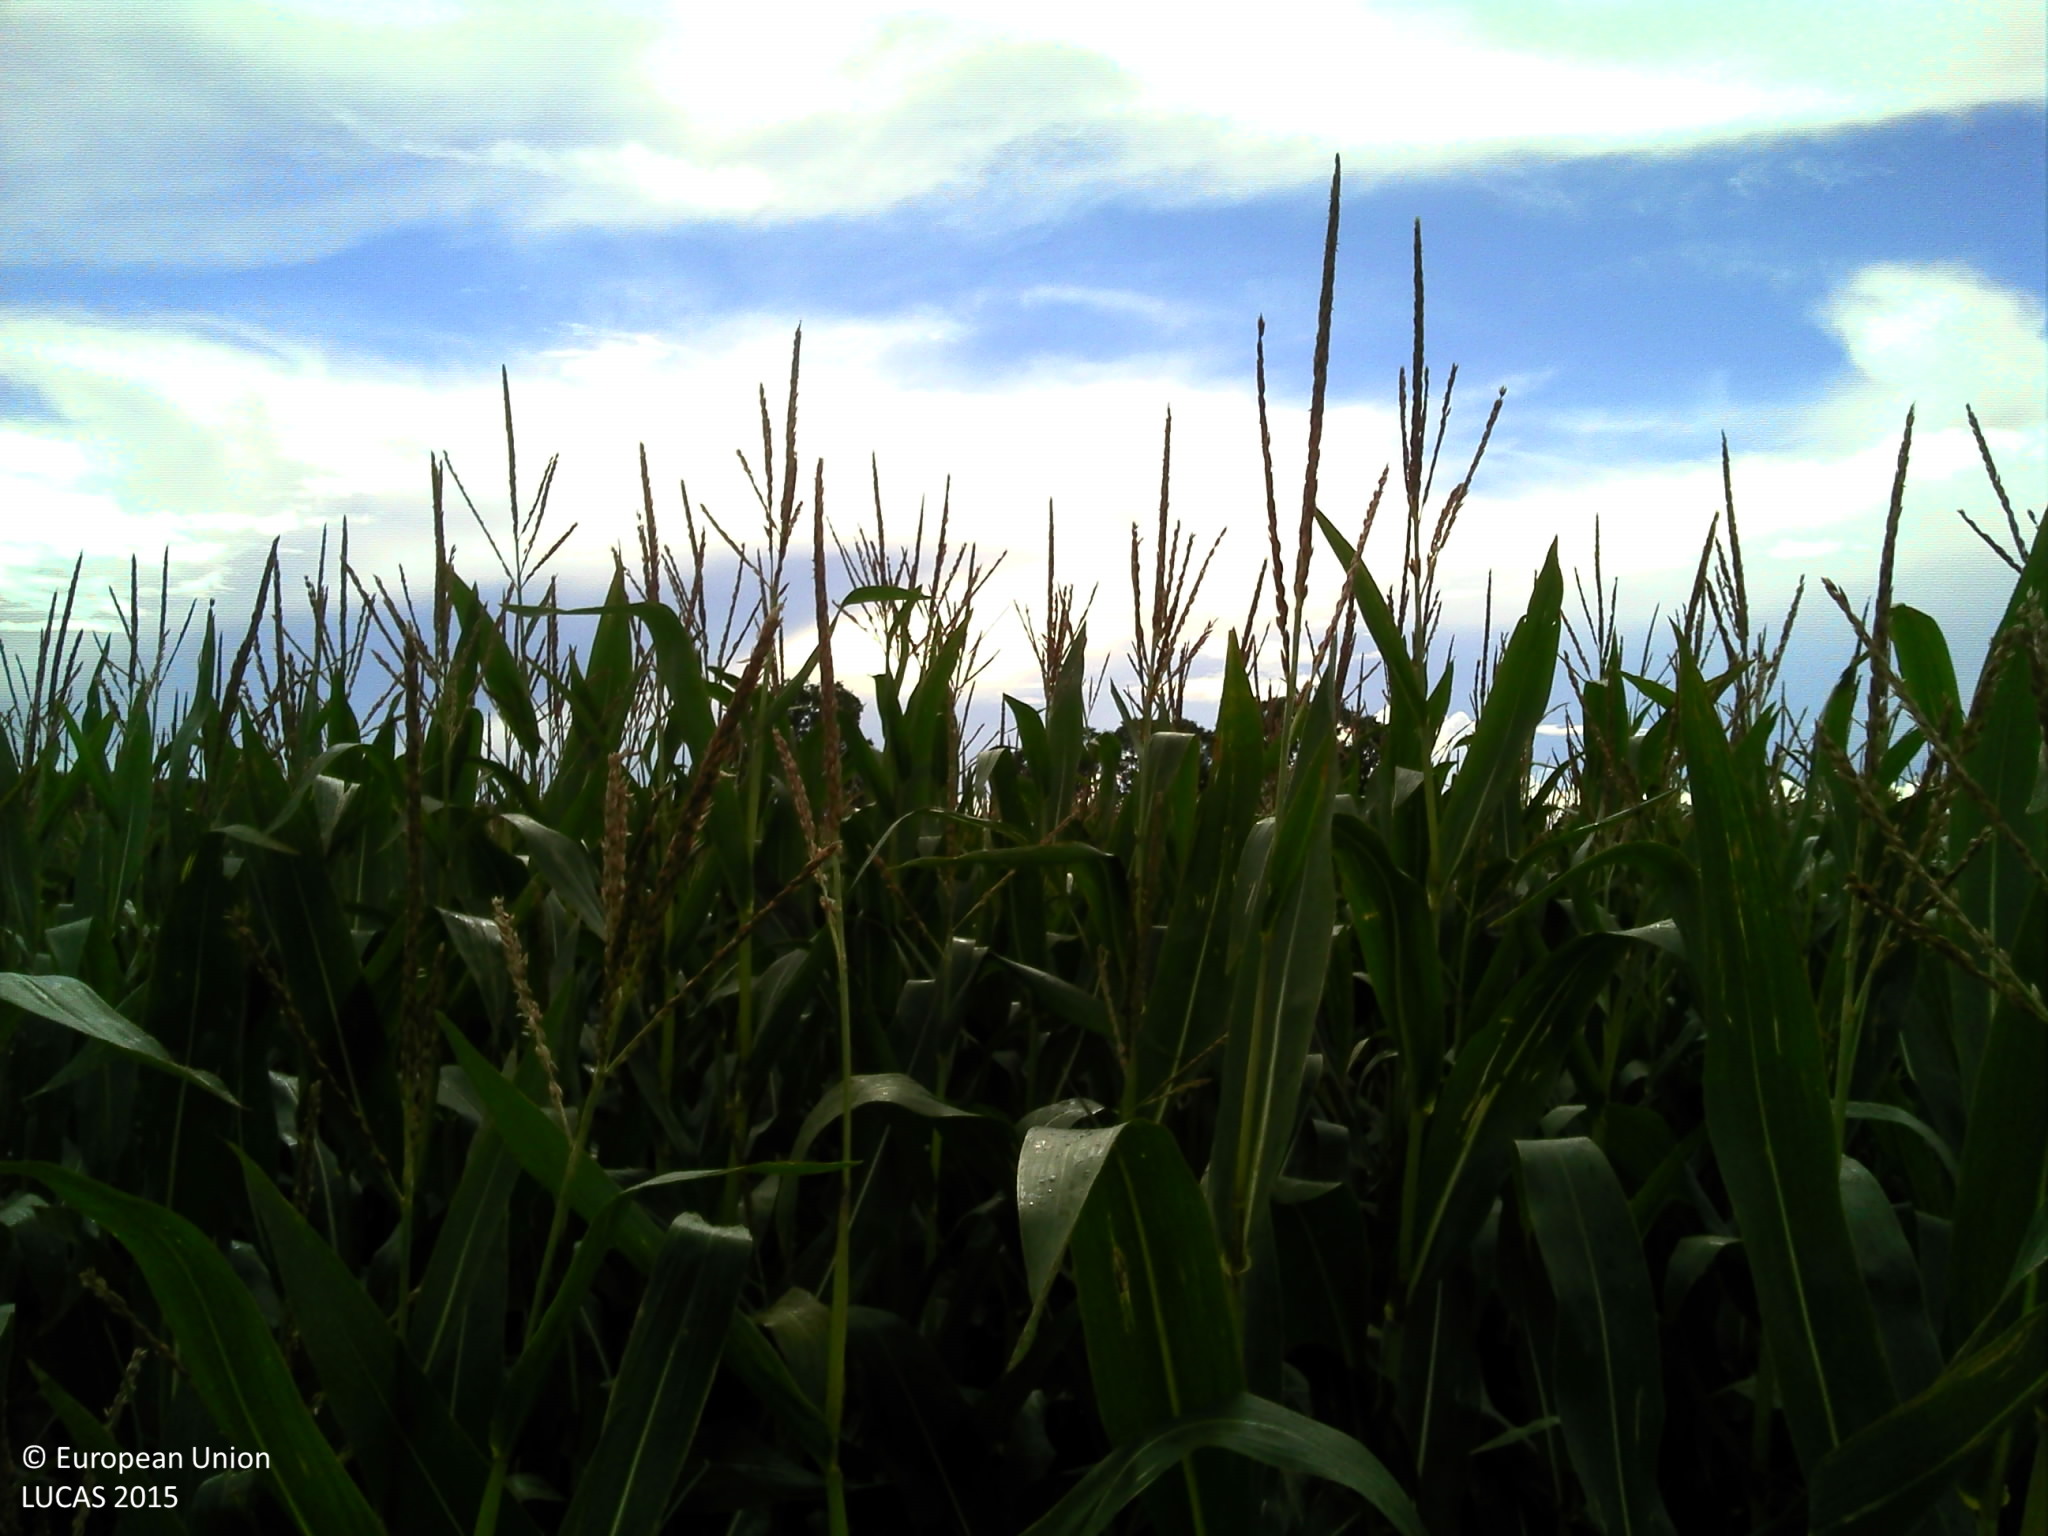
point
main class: Cropland
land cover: Maize
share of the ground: > 75 %
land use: Agriculture (excluding fallow land and kitchen gardens)
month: September
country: BE
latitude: 51.3198
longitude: 4.6441
